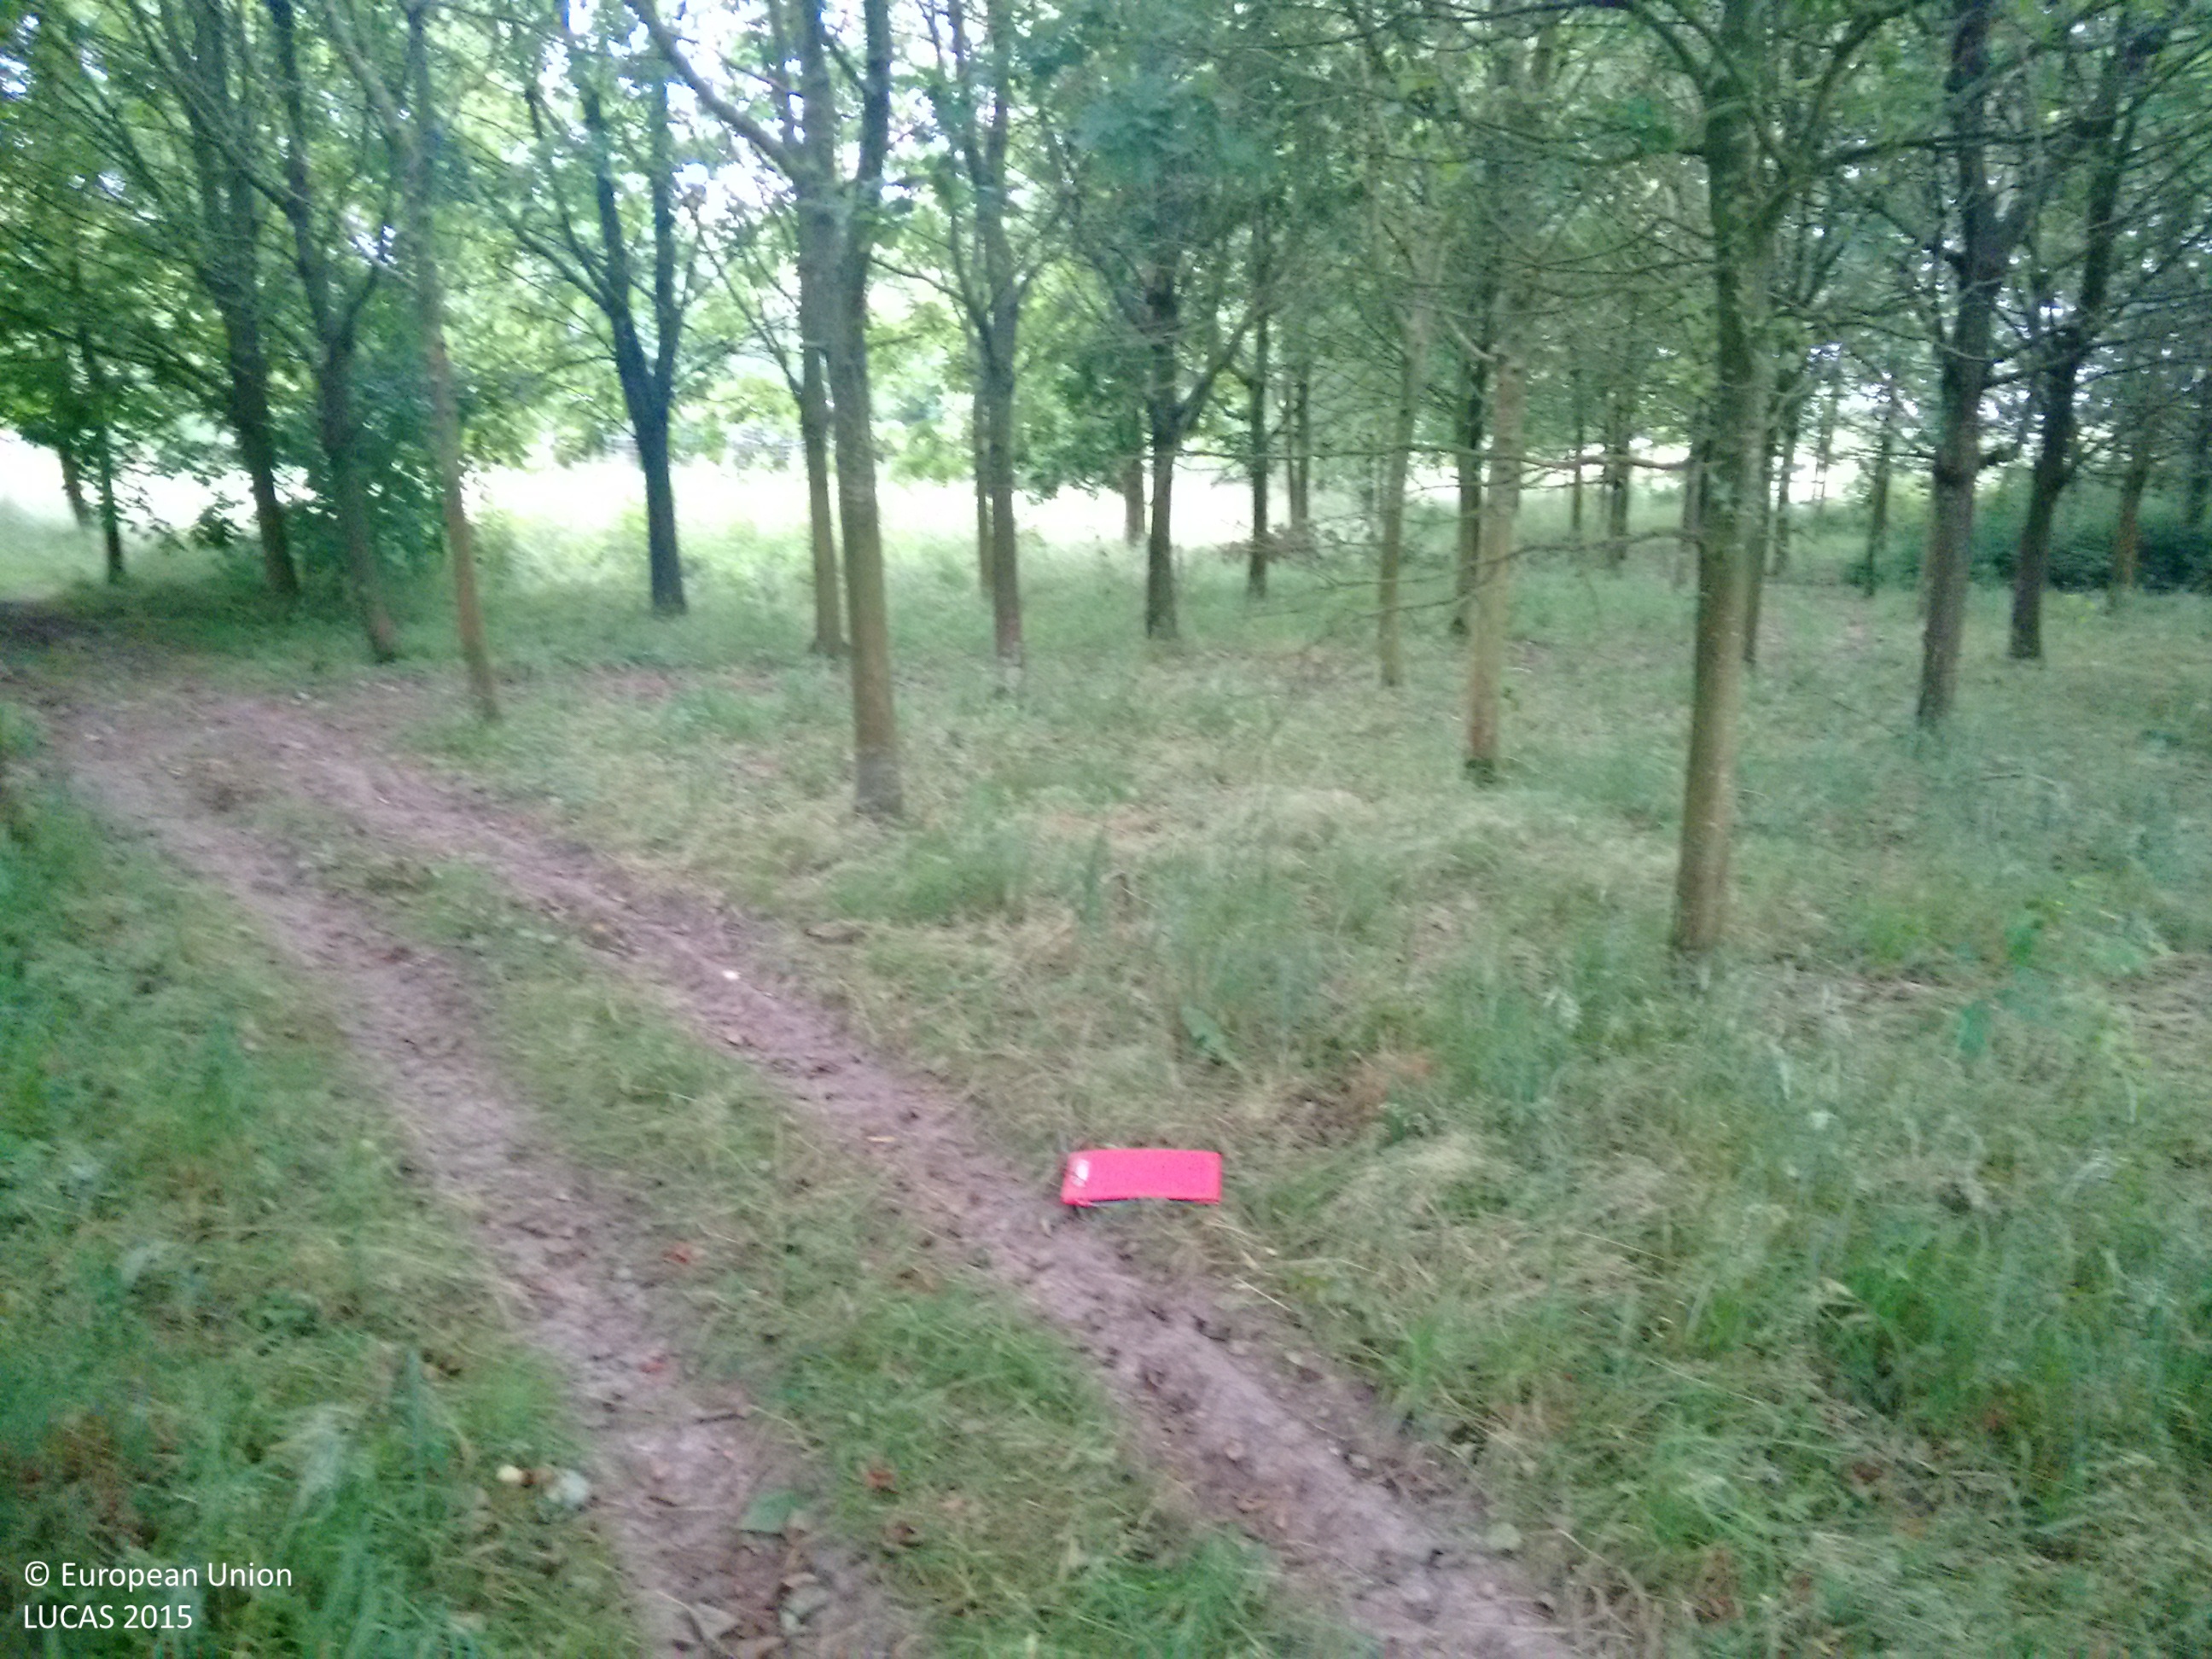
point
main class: Woodland
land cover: Broadleaved woodland
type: mesophytic deciduous forest
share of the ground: > 75 %
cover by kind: broadleaved forest trees 100 %
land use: Forestry
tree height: > 5 m
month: July
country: GB
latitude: 50.9099
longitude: -0.9233
